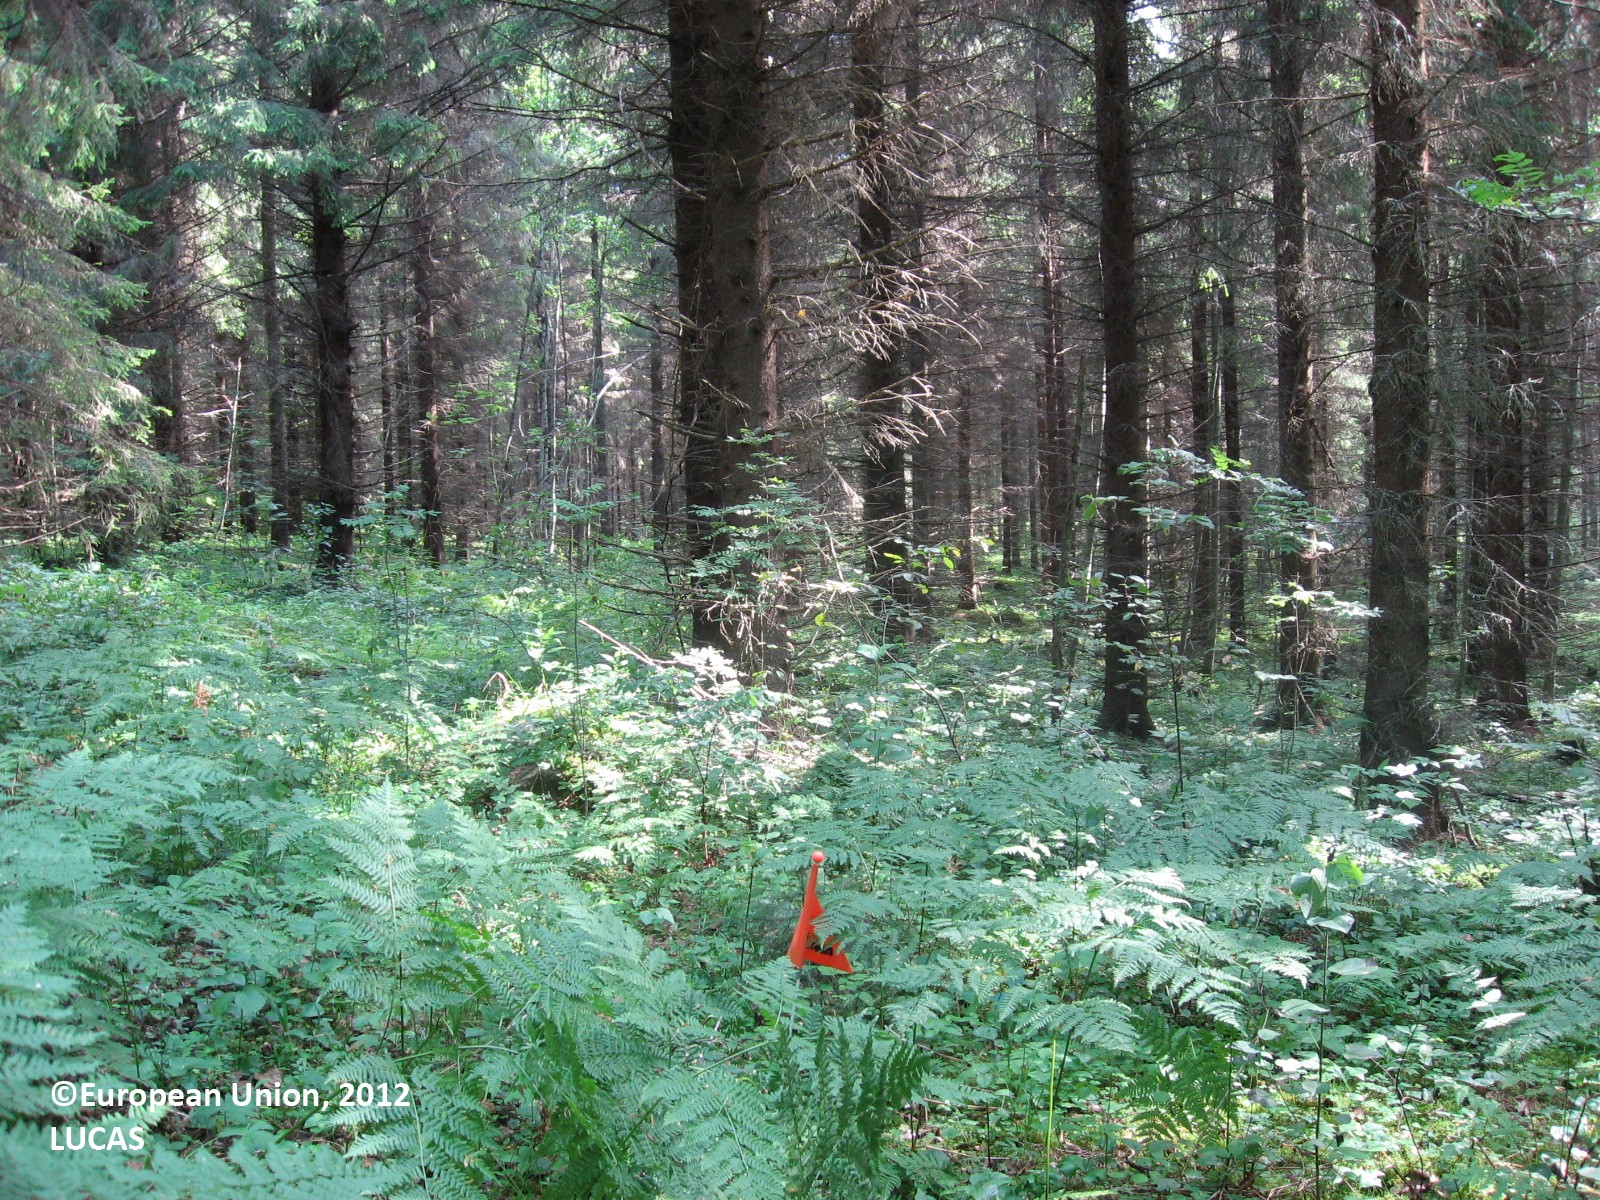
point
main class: Woodland
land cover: Spruce dominated coniferous woodland
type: boreal forest
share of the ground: > 75 %
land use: Forestry
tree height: > 5 m
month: August
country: FI
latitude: 61.5403
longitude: 25.8750
